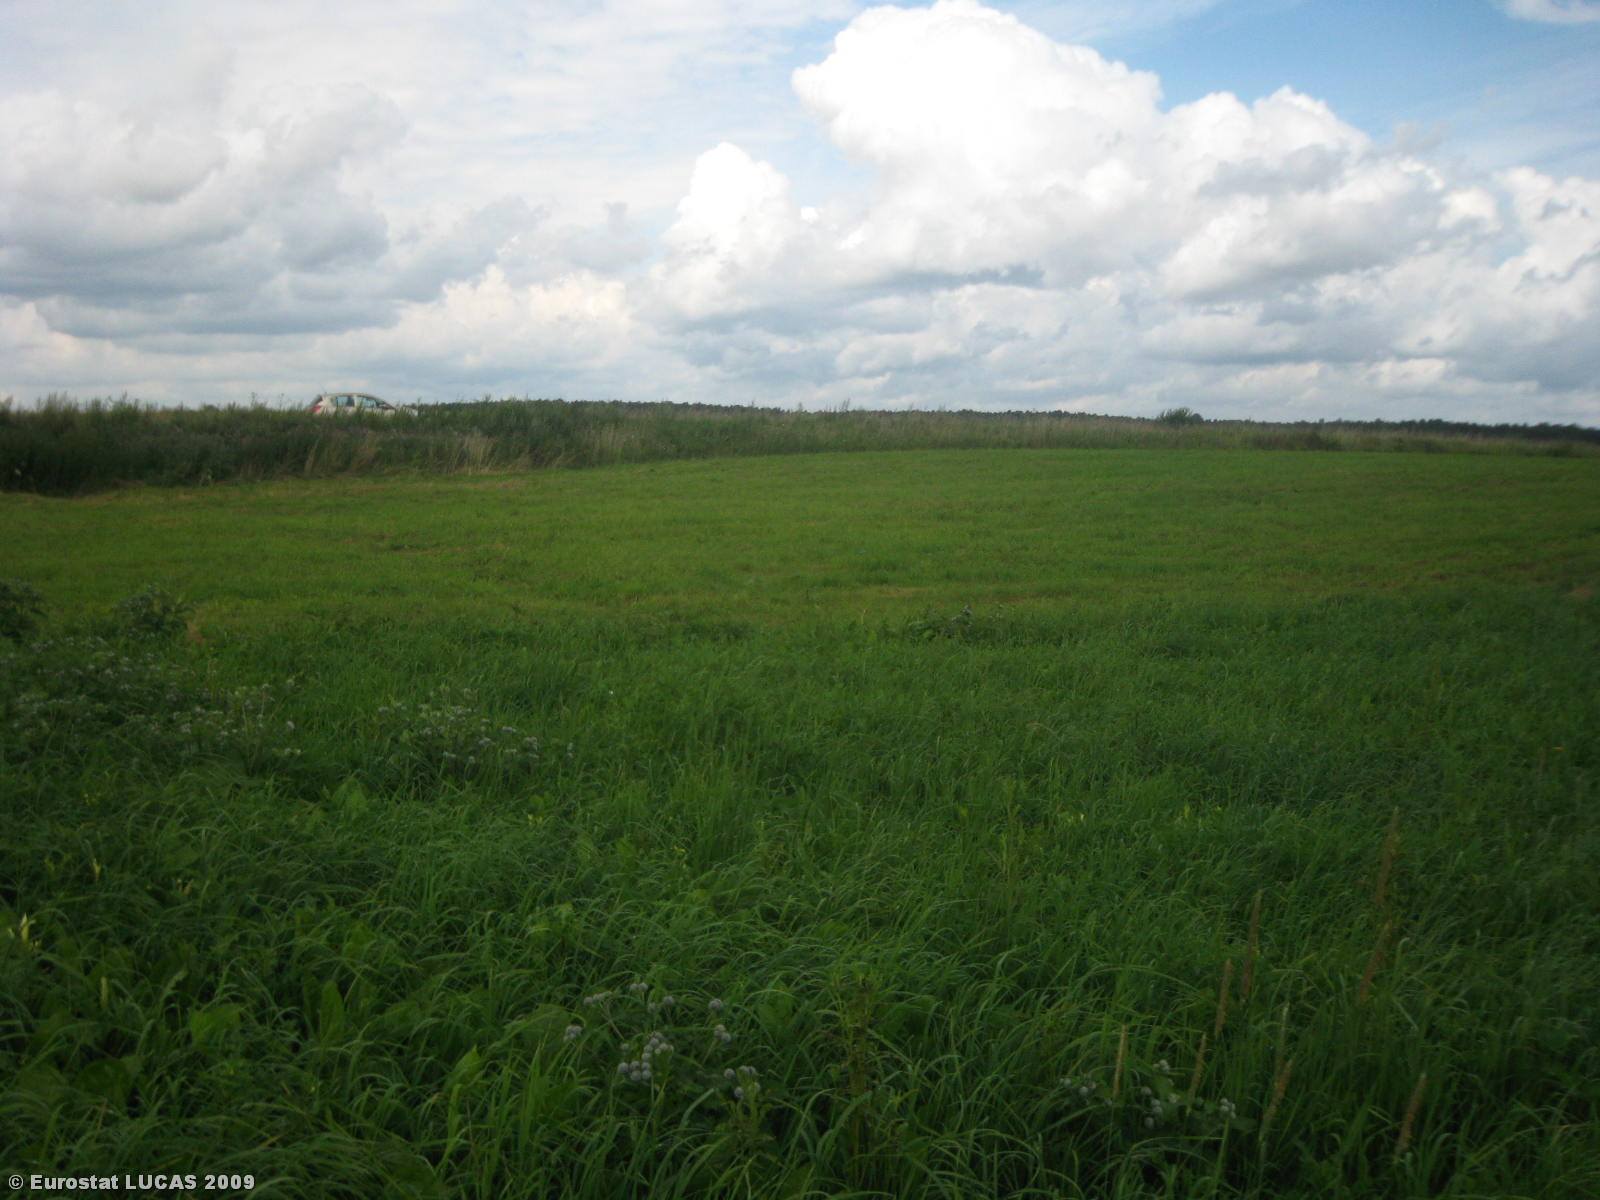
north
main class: Grassland
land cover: Grassland without tree/shrub cover
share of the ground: > 75 %
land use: Agriculture (excluding fallow land and kitchen gardens)
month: July
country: LT
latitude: 55.0615
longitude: 23.5623
